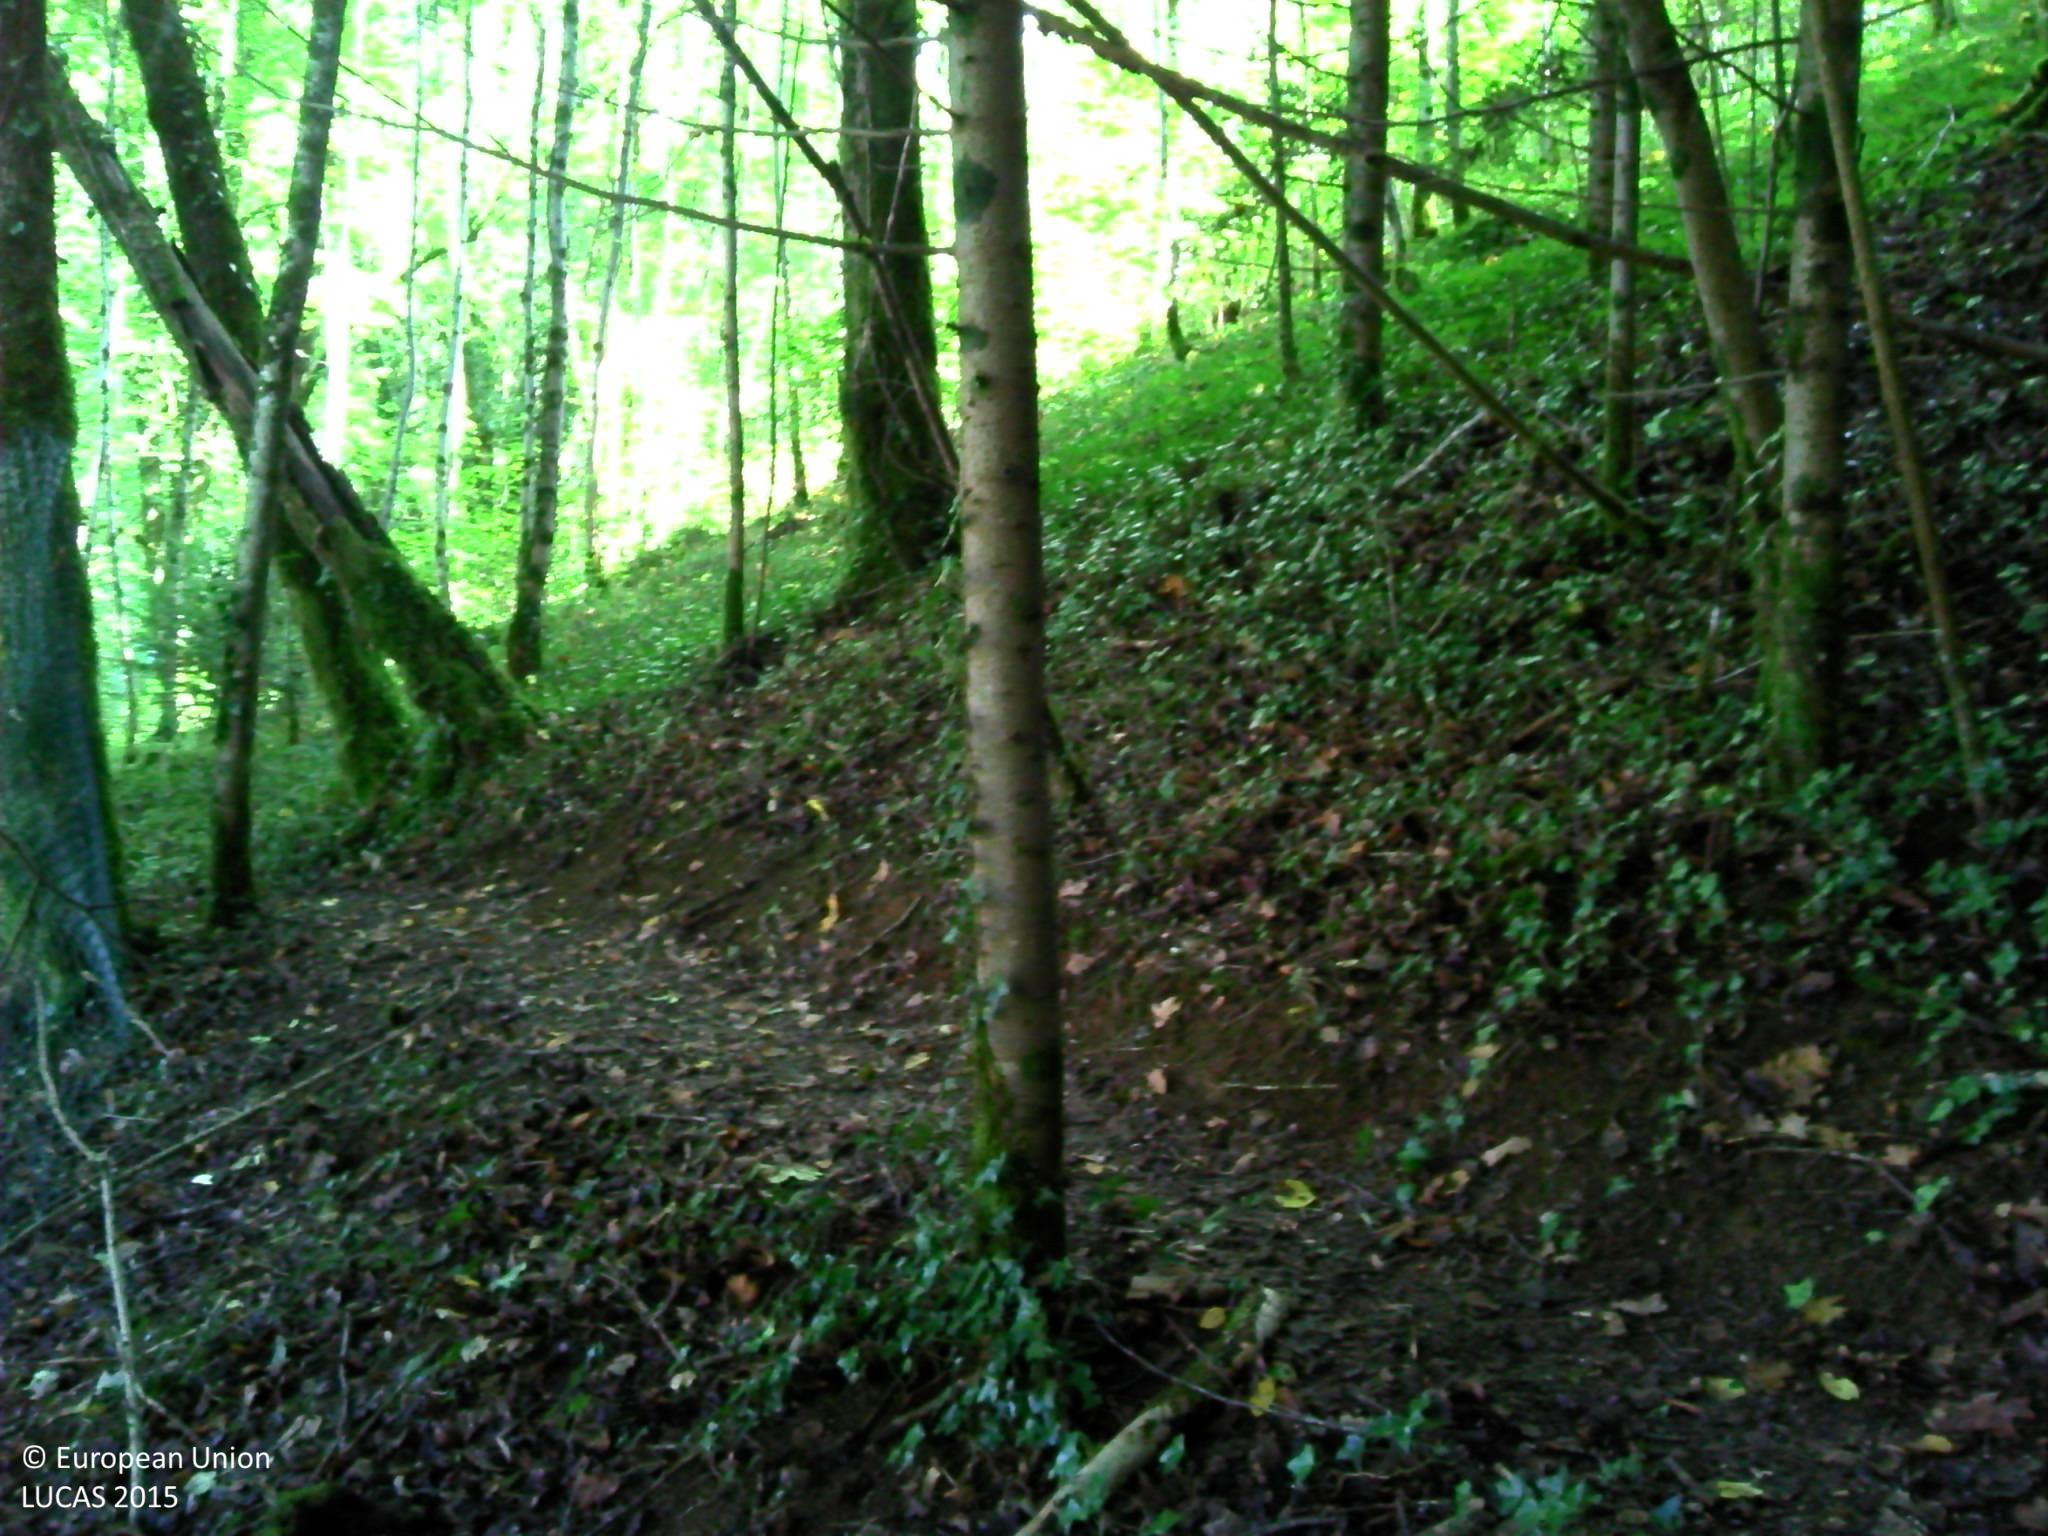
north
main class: Woodland
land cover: Broadleaved woodland
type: floodplain forest
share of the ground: > 75 %
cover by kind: broadleaved forest trees 90 %, herbaceous plants 5 %, unconsolidated bare surface 5 %
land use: Forestry
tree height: > 5 m
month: September
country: FR
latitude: 47.1099
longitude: 6.1144
